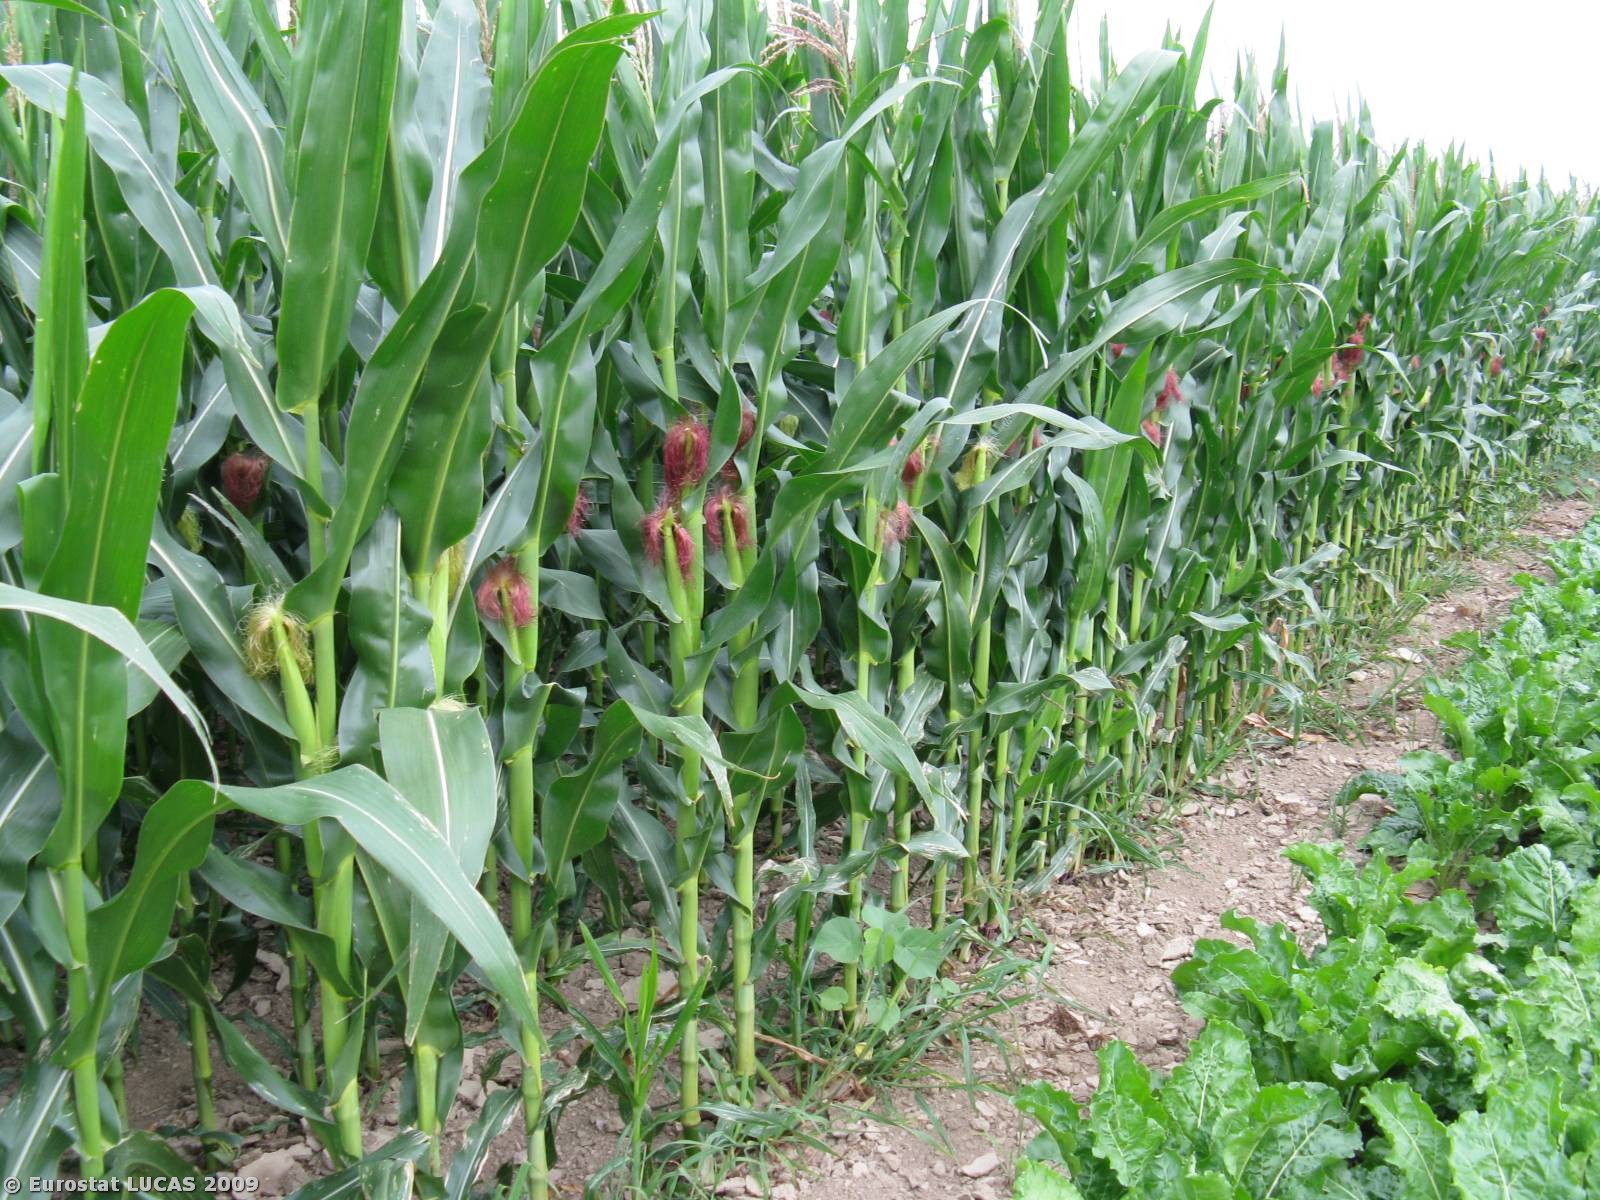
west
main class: Cropland
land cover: Maize
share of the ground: > 75 %
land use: Agriculture (excluding fallow land and kitchen gardens)
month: June
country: IT
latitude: 44.8785
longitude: 11.6551
